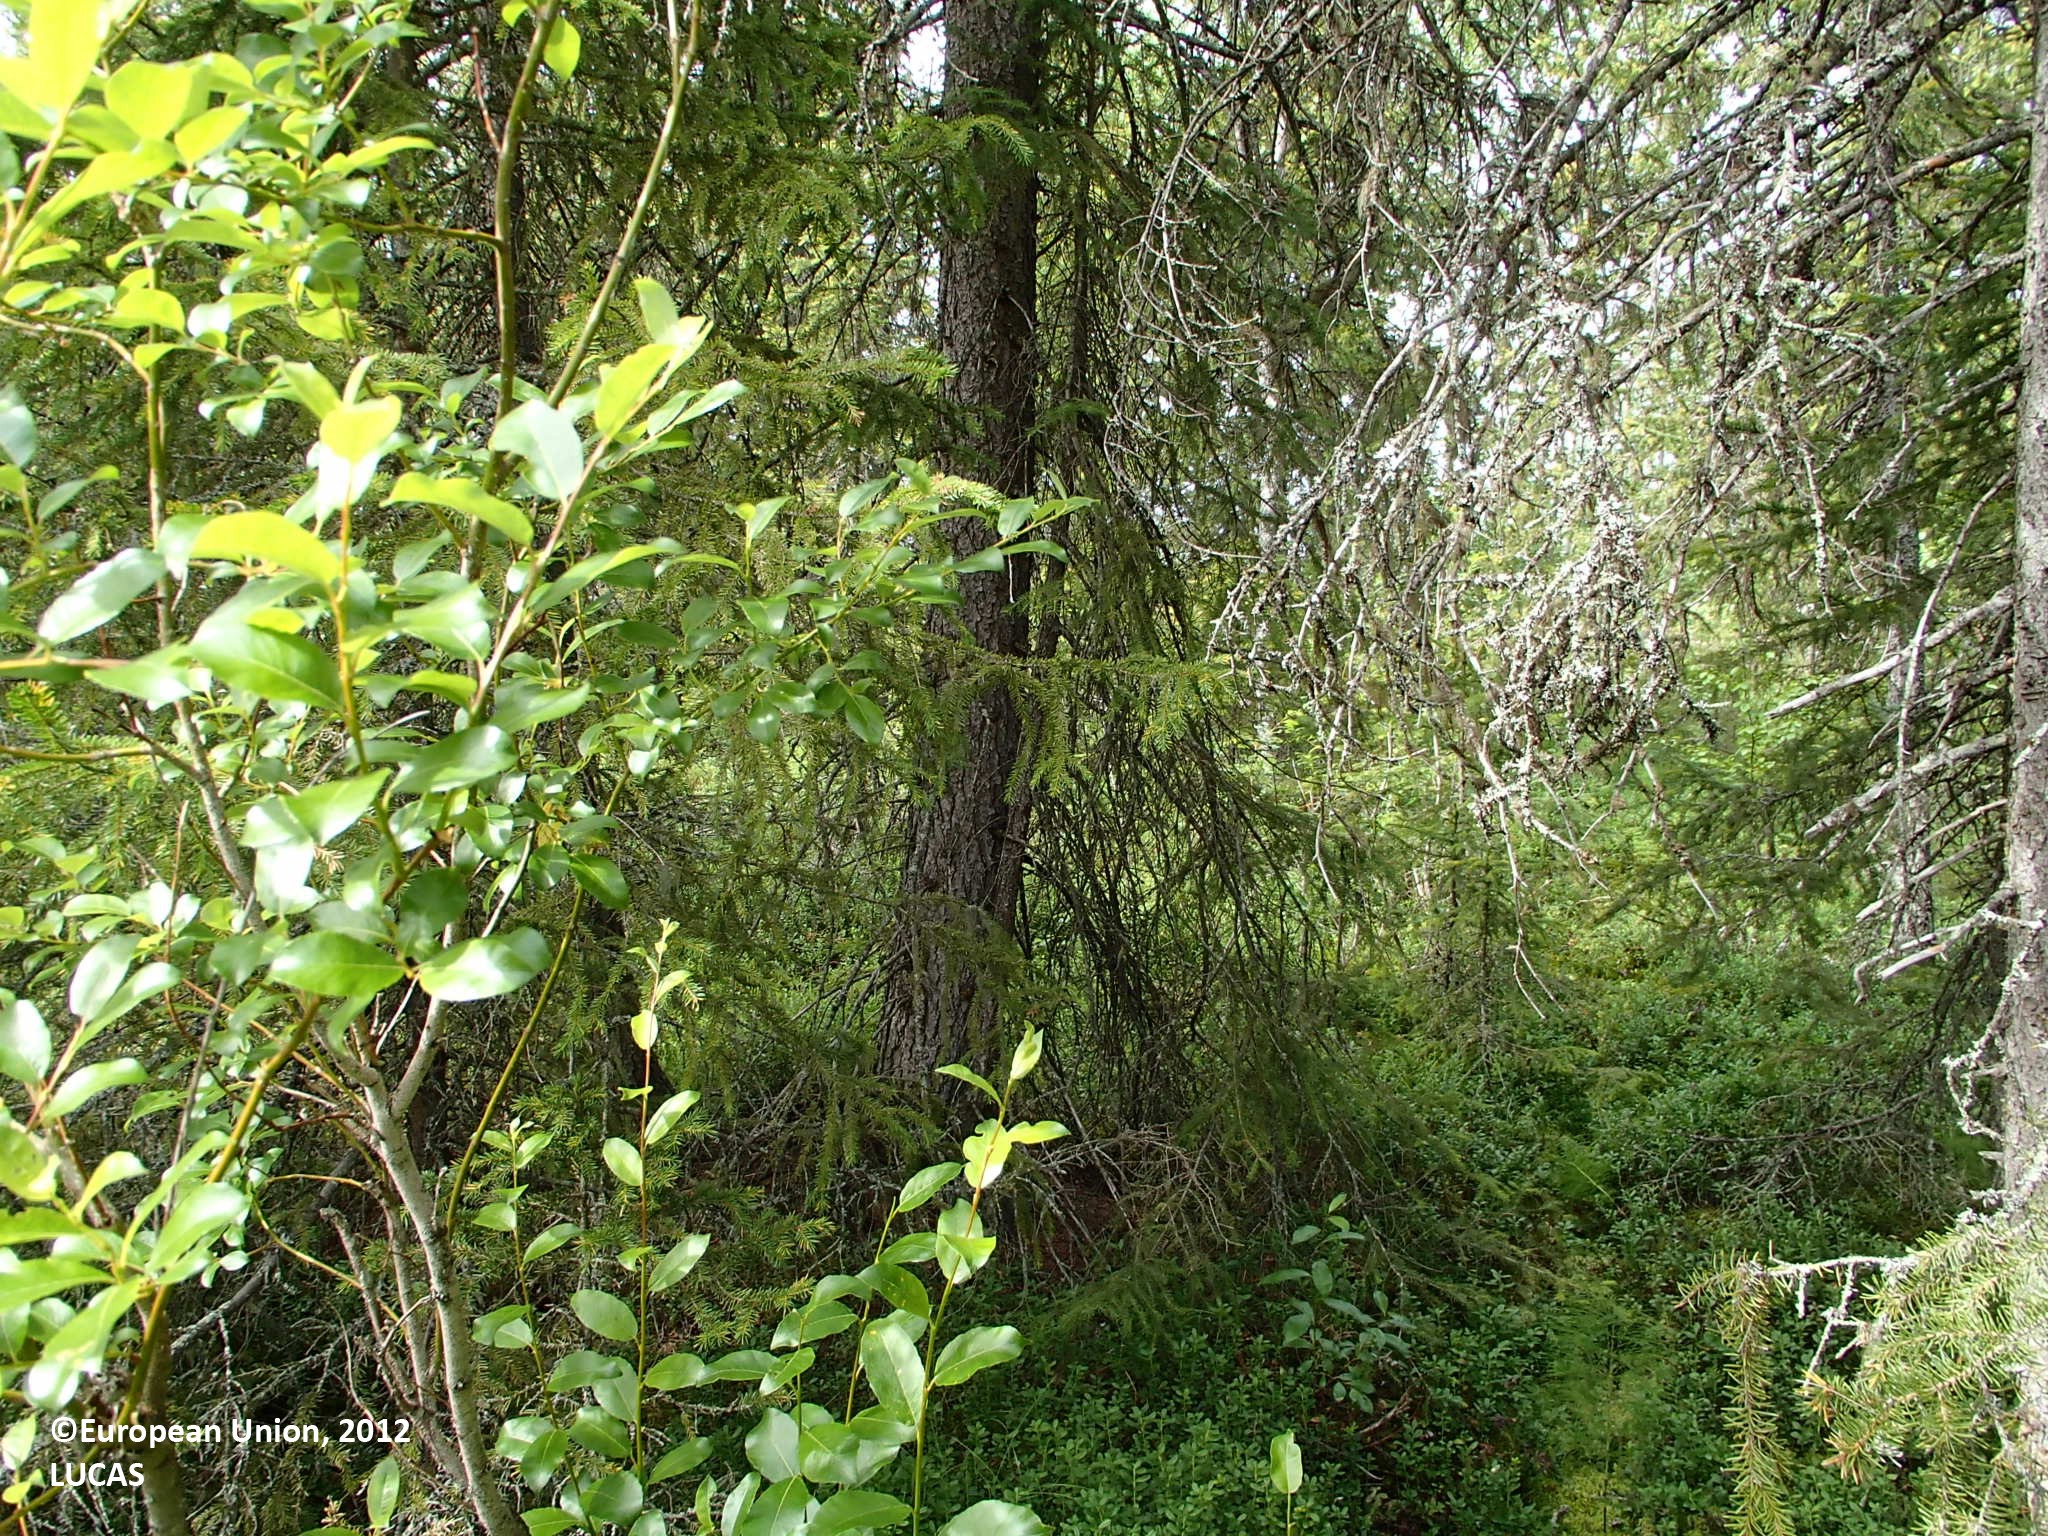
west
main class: Woodland
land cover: Spruce dominated coniferous woodland
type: boreal forest
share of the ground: > 75 %
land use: Forestry
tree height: > 5 m
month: July
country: FI
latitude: 66.4477
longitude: 25.6547
